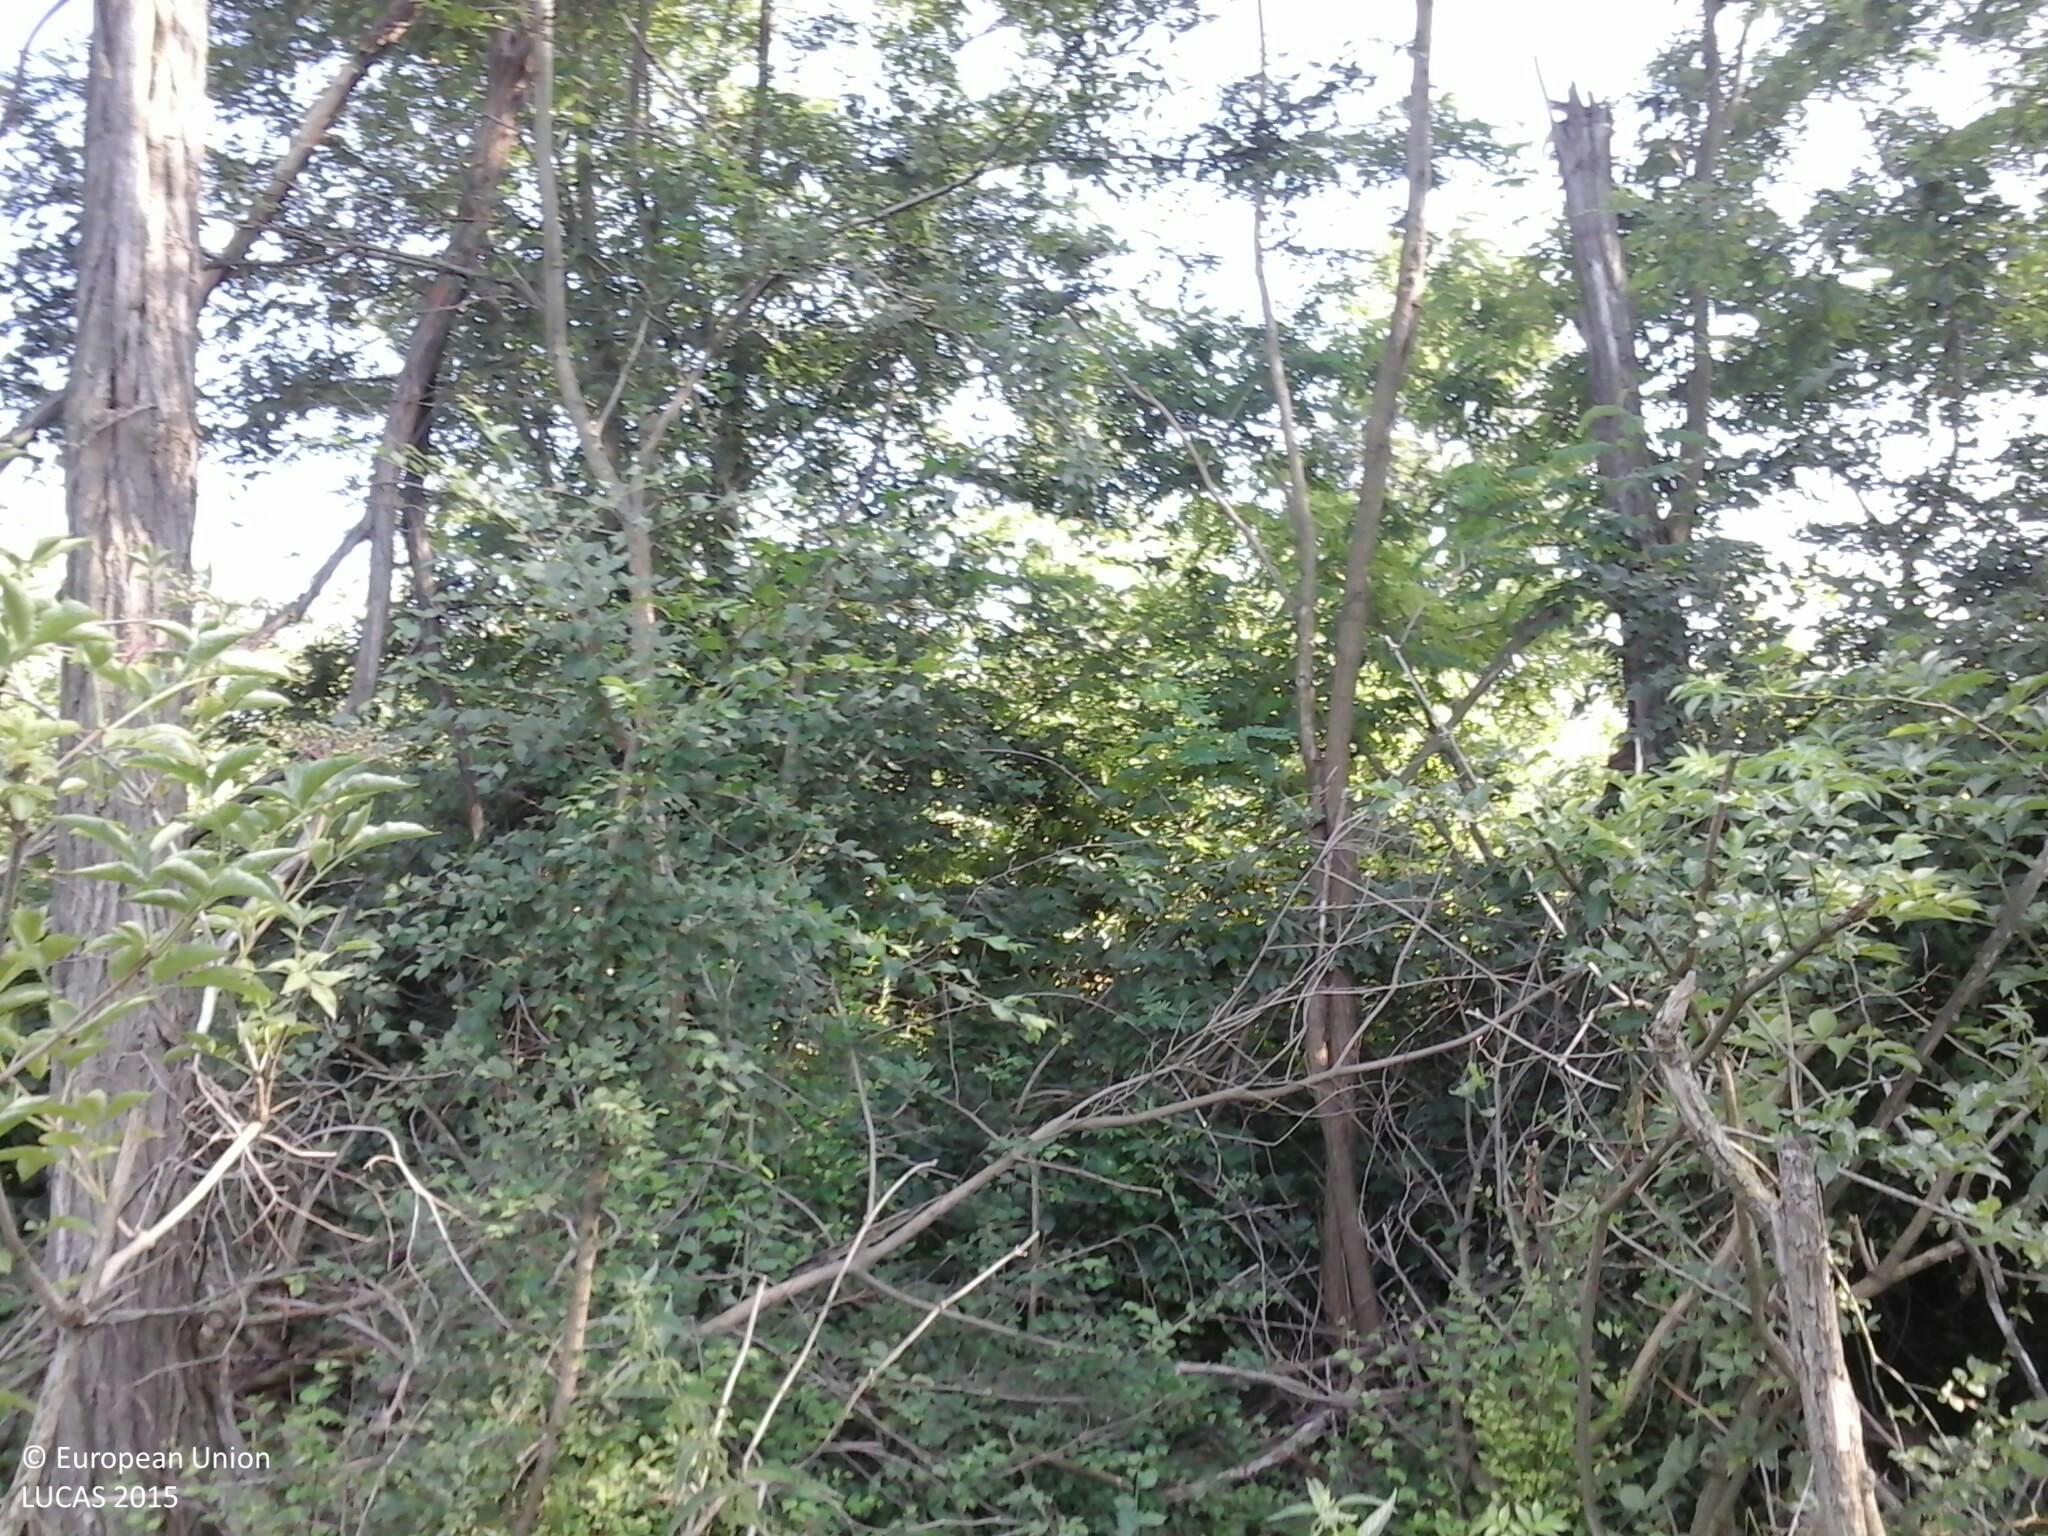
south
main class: Woodland
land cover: Broadleaved woodland
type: exotic forest
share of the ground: > 75 %
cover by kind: broadleaved forest trees 75 %, herbaceous plants 15 %, shrubs 10 %
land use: Forestry
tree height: > 5 m
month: July
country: HU
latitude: 46.9747
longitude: 17.2218
